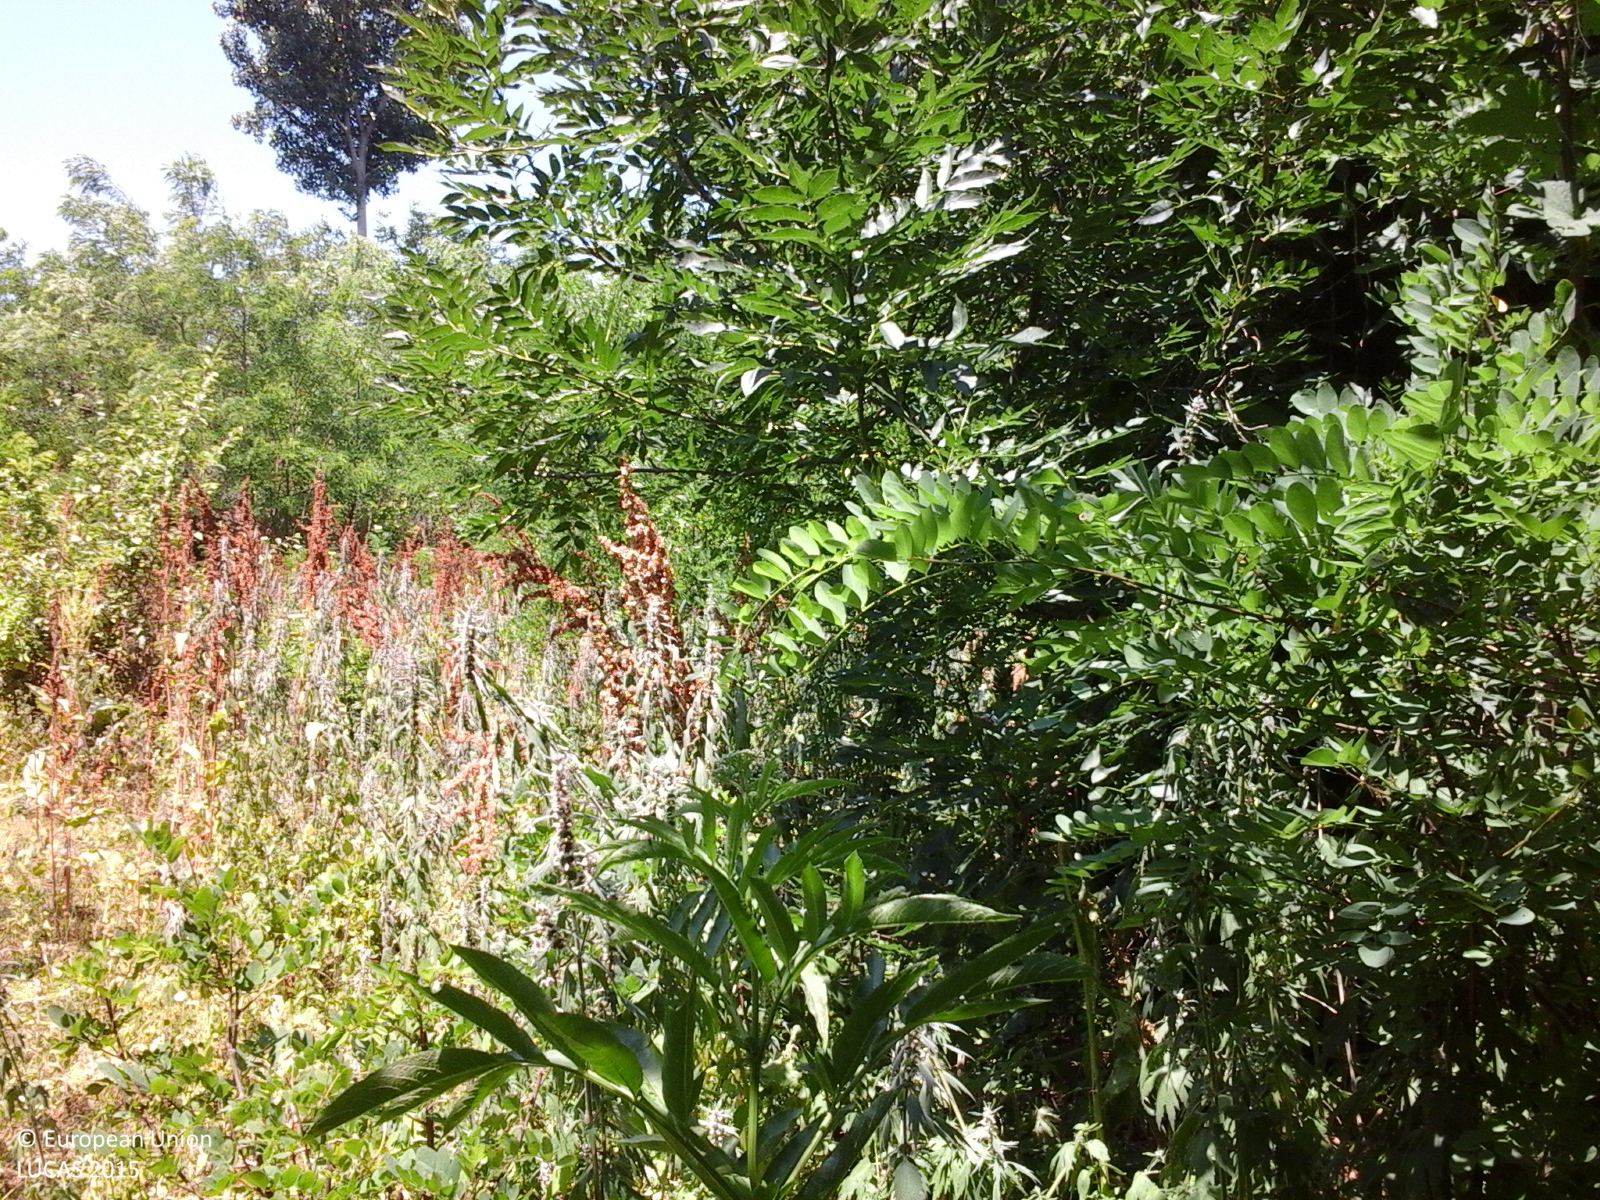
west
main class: Woodland
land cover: Broadleaved woodland
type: beech forest
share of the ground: > 75 %
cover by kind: broadleaved forest trees 100 %
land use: Forestry
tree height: > 5 m
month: June
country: RO
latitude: 46.8141
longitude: 28.0191
